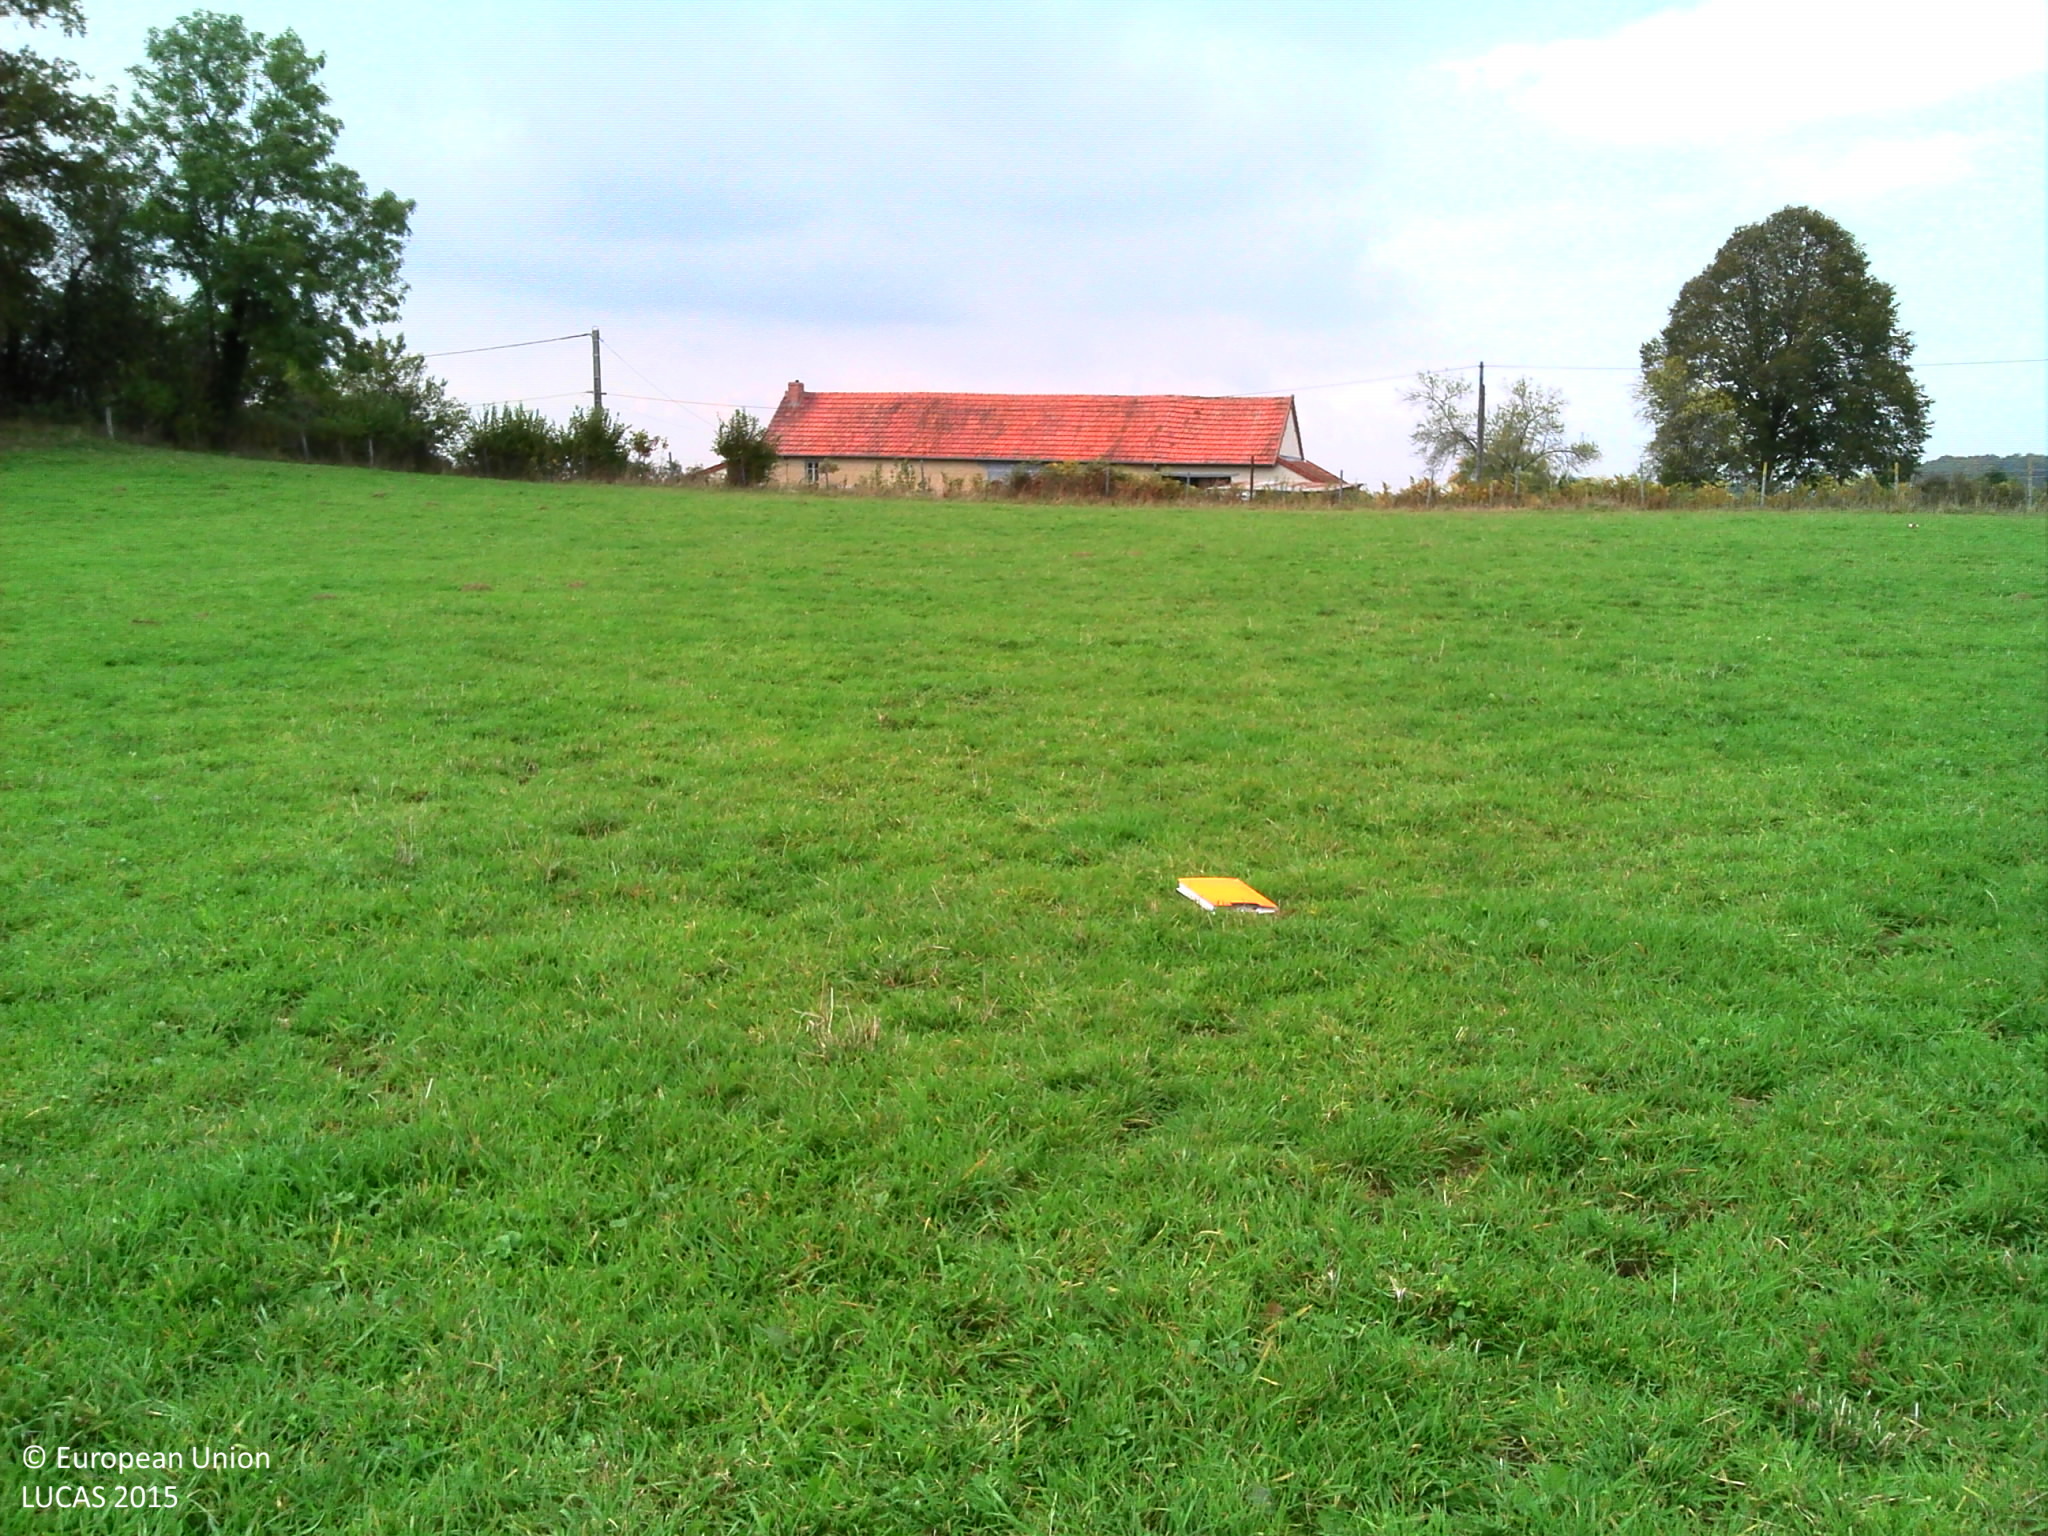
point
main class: Grassland
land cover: Grassland without tree/shrub cover
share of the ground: > 75 %
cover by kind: herbaceous plants 100 %
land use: Agriculture (excluding fallow land and kitchen gardens)
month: October
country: FR
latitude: 46.1598
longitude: 2.7583
